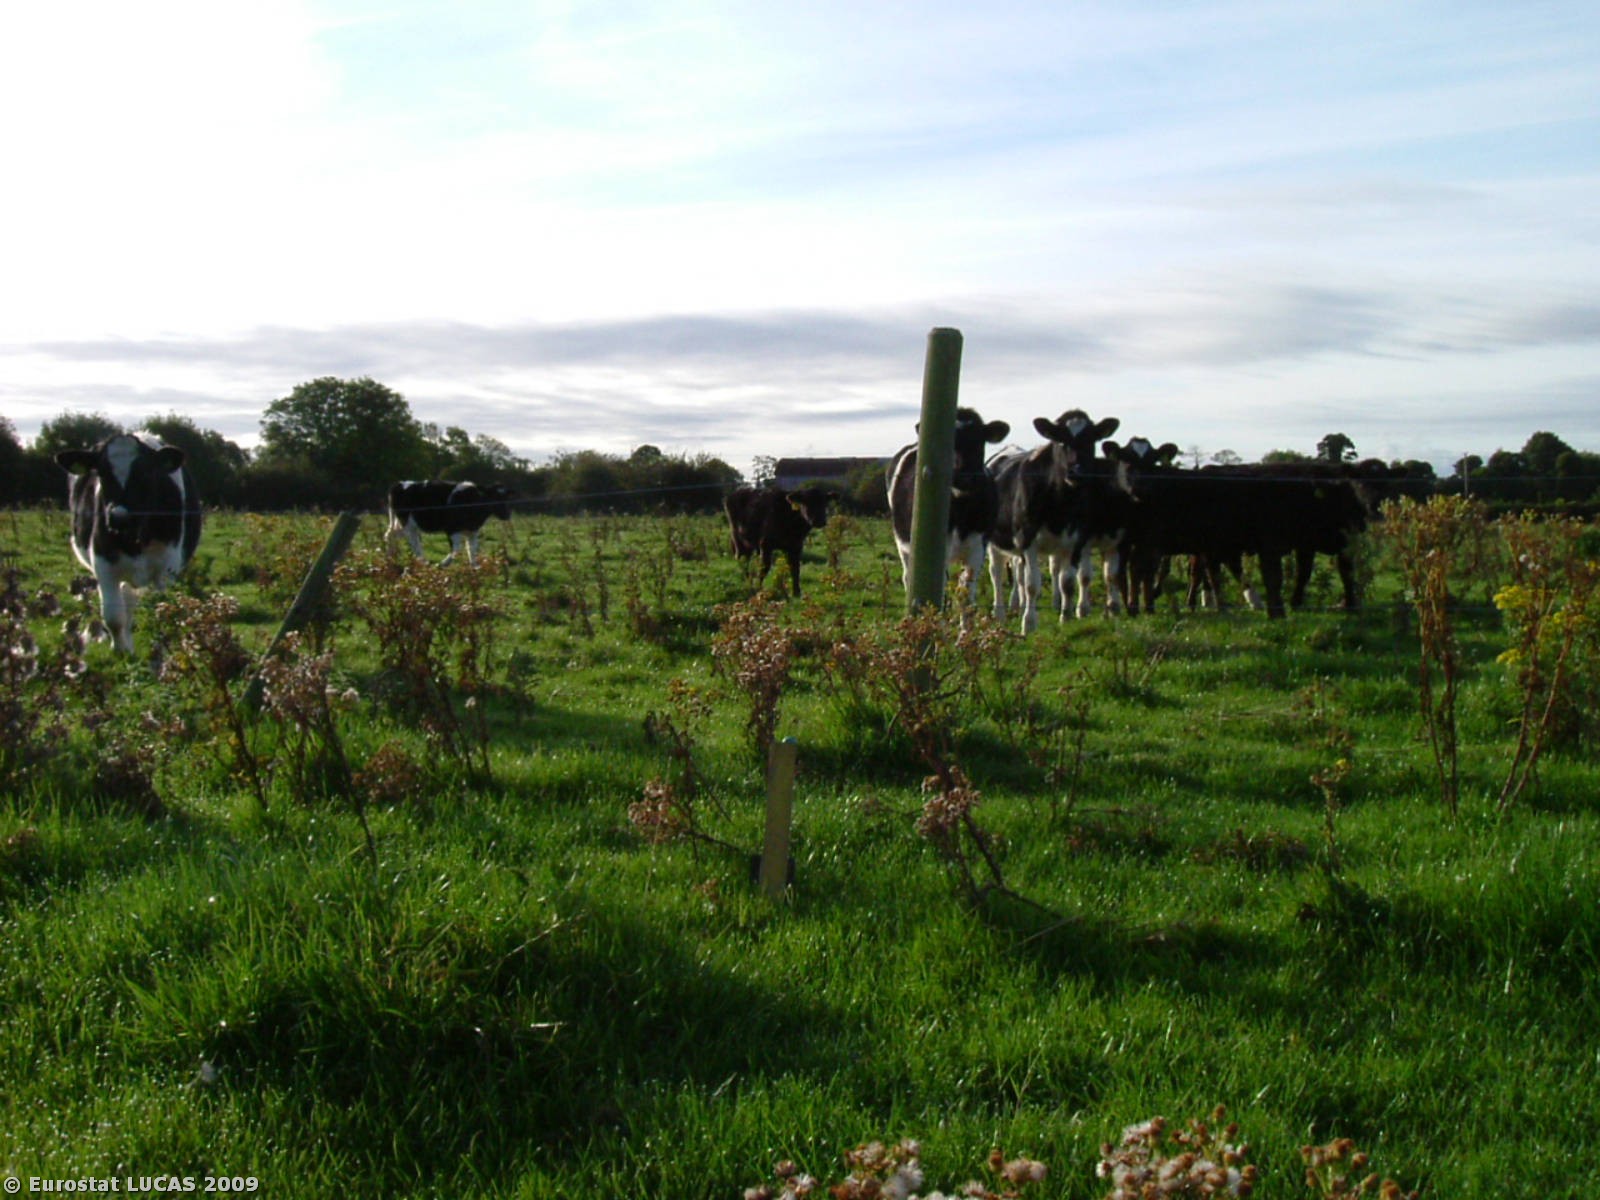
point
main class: Grassland
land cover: Grassland without tree/shrub cover
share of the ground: > 75 %
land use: Agriculture (excluding fallow land and kitchen gardens)
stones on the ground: < 10 %
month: October
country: IE
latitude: 52.6477
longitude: -7.7409
